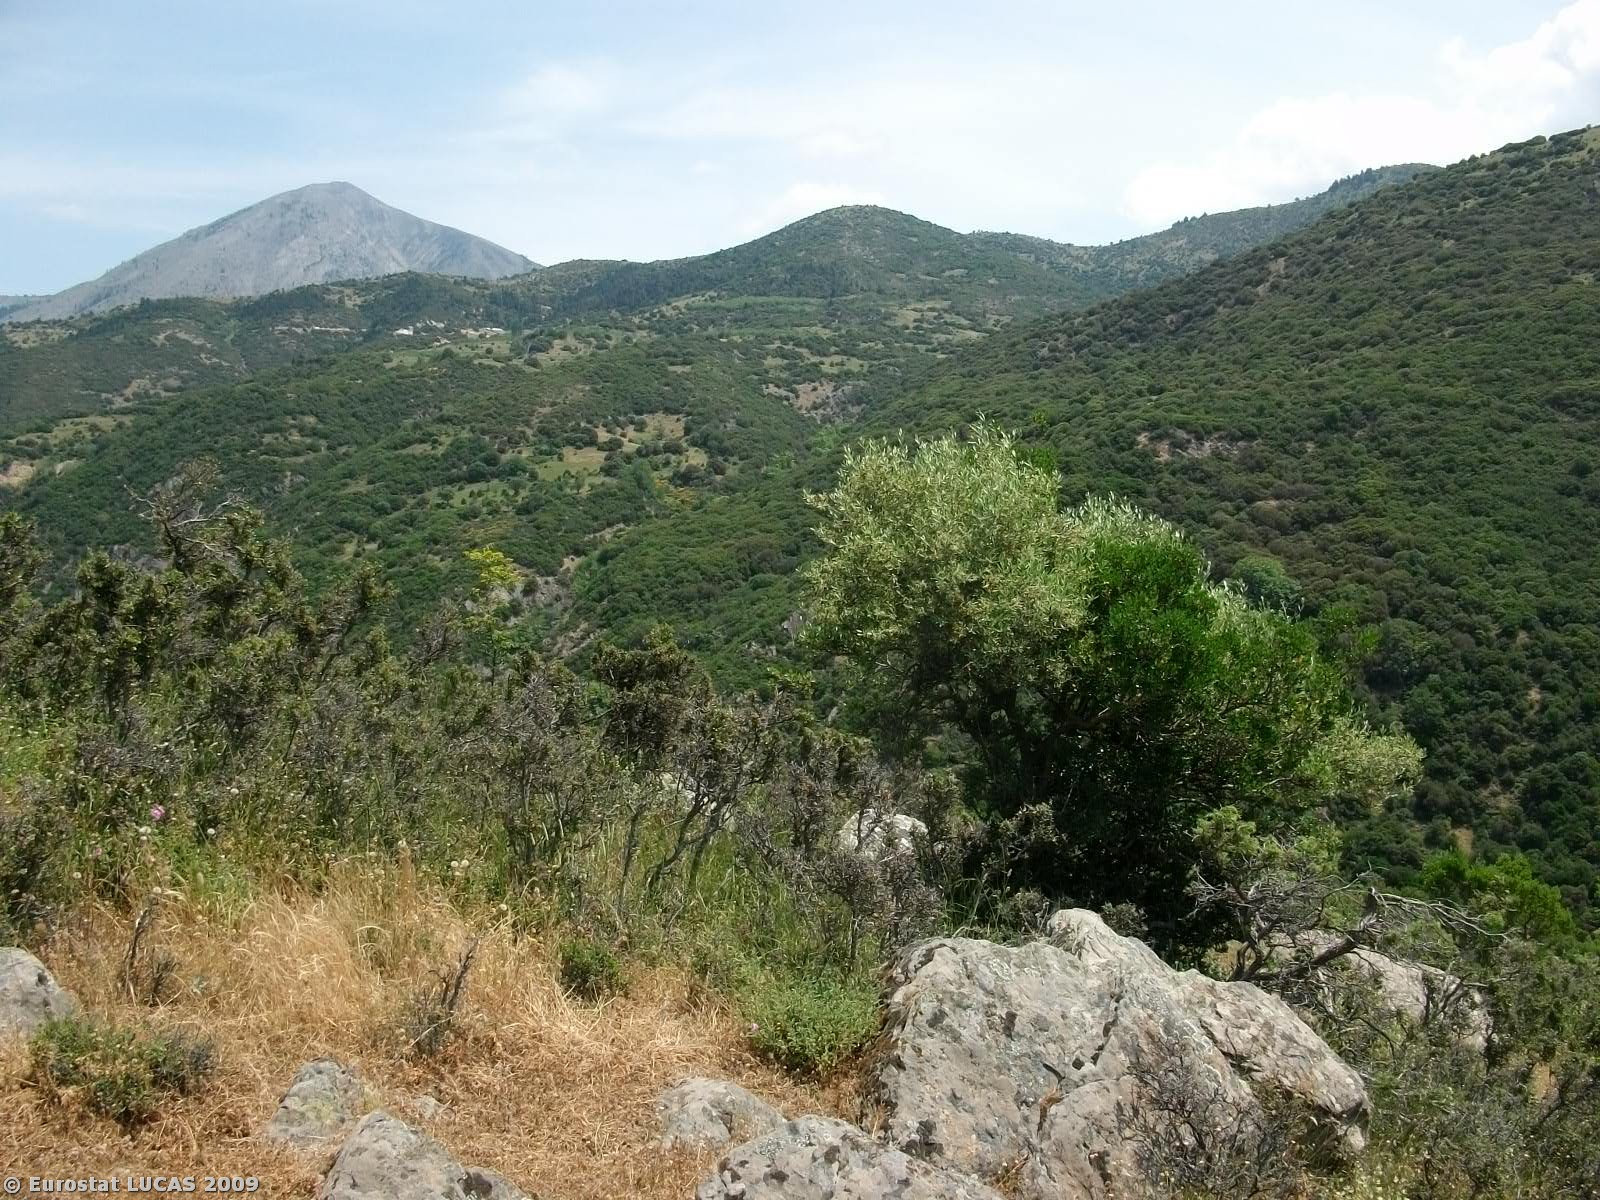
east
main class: Grassland
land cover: Grassland with sparse tree/shrub cover
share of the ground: > 75 %
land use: Agriculture (excluding fallow land and kitchen gardens)
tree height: < 5 m
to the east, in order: Grassland with sparse tree/shrub cover; Shrubland with sparse tree cover
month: May
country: GR
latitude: 39.7788
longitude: 22.6148
